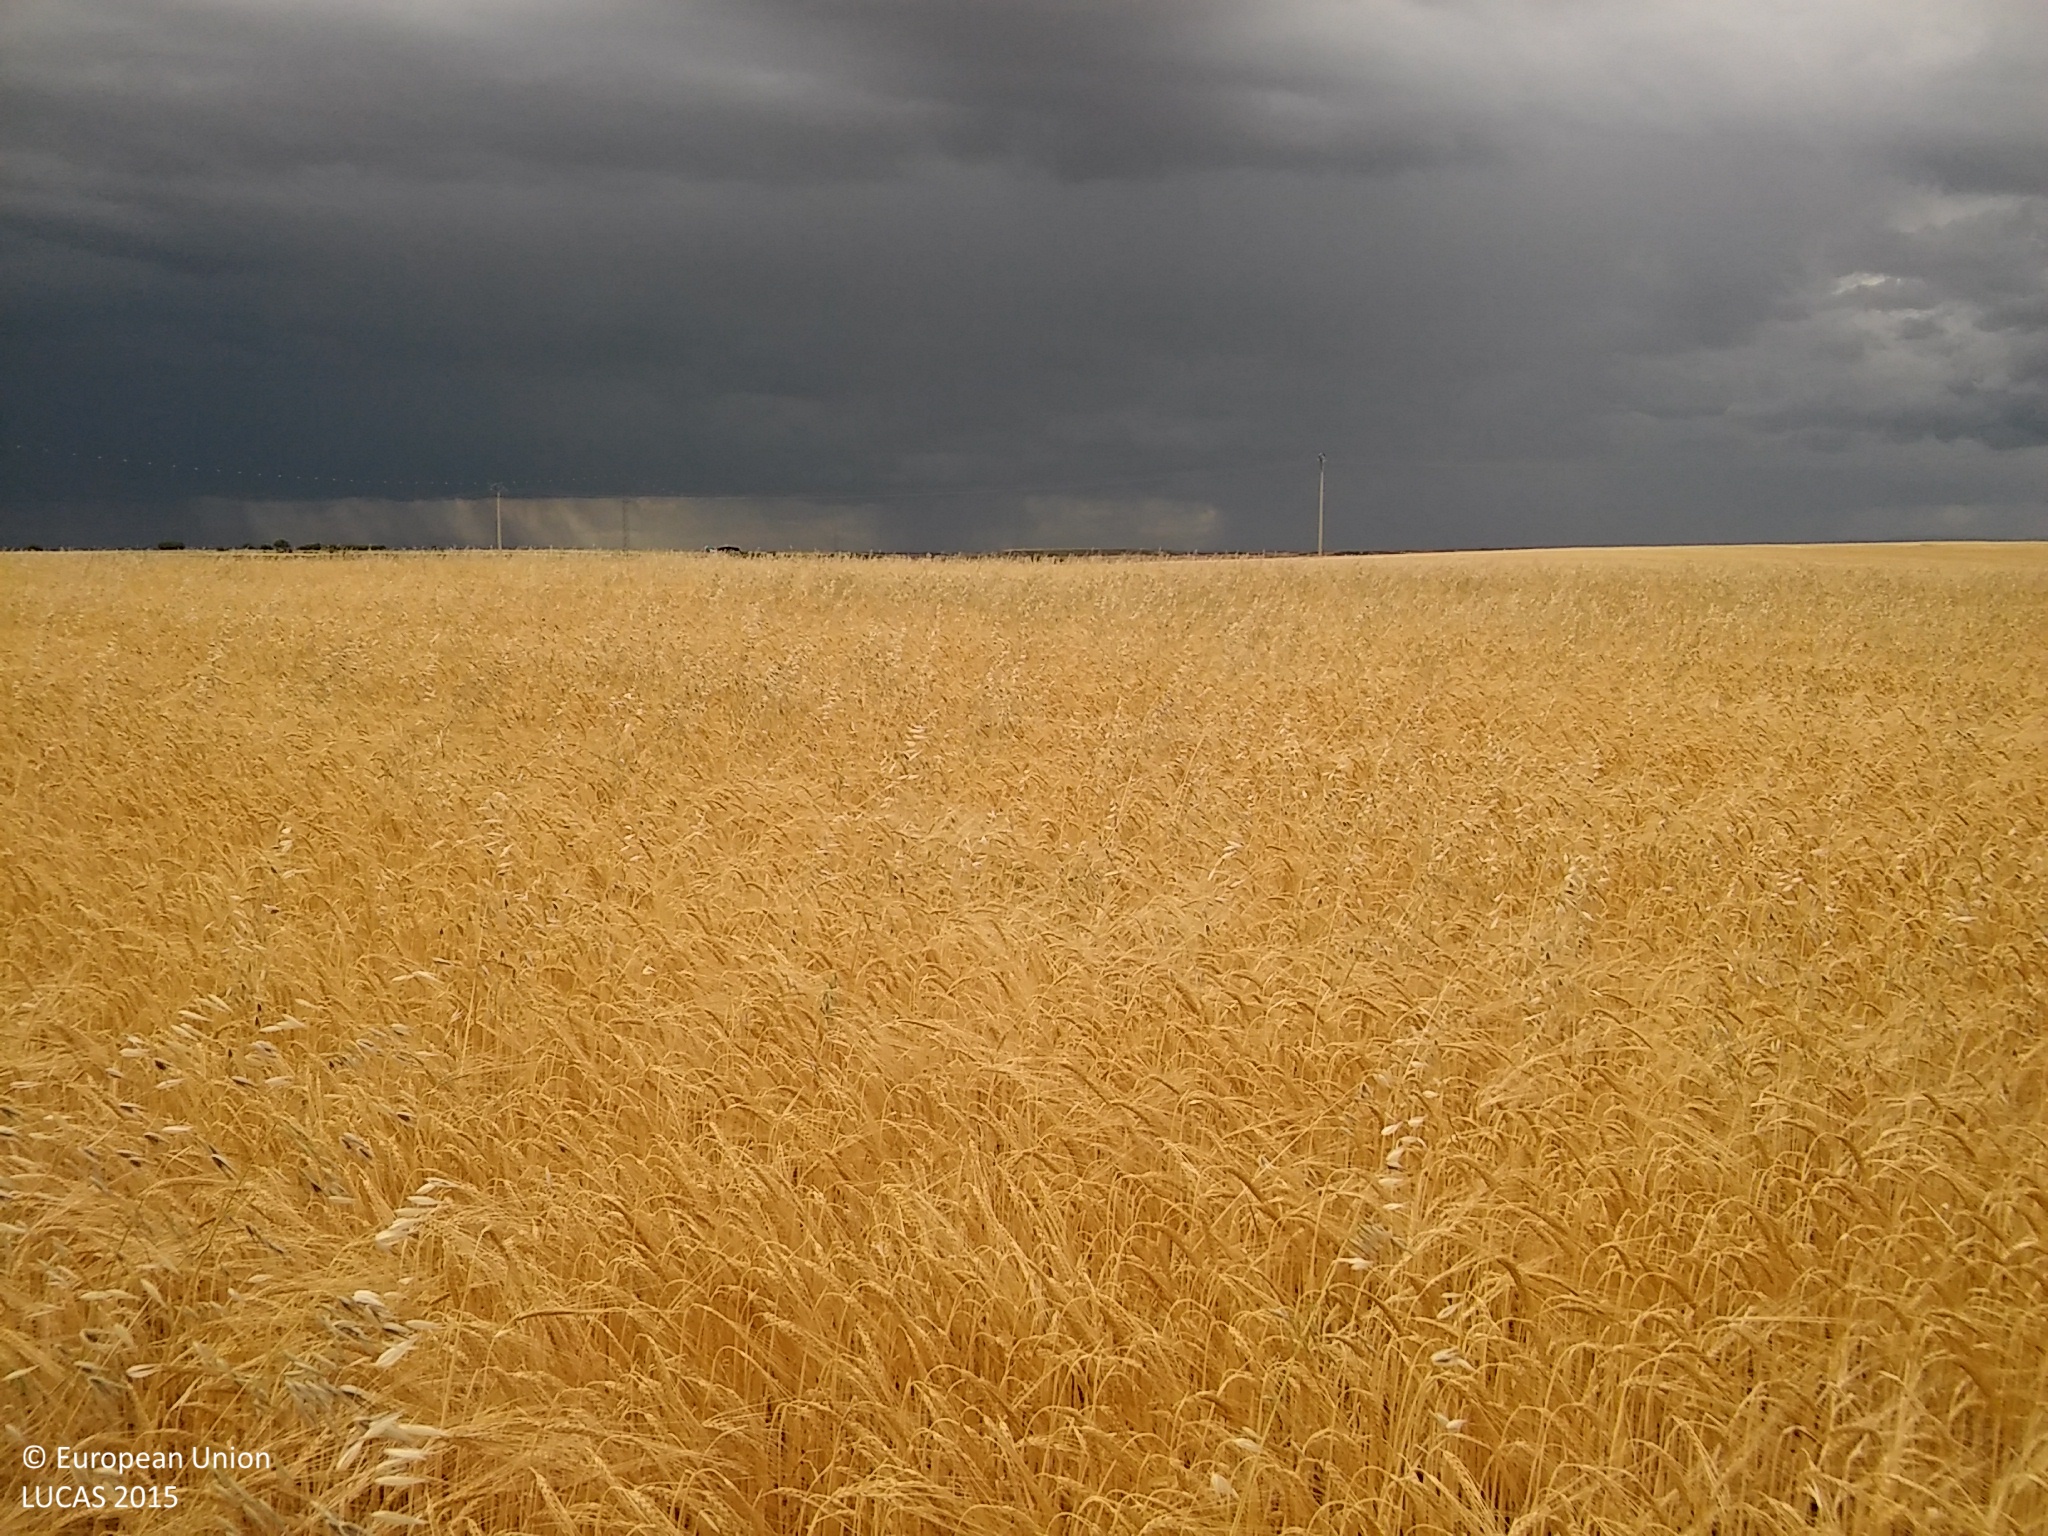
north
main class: Cropland
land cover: Barley
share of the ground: > 75 %
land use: Agriculture (excluding fallow land and kitchen gardens)
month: June
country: ES
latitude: 41.5427
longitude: -3.7781
